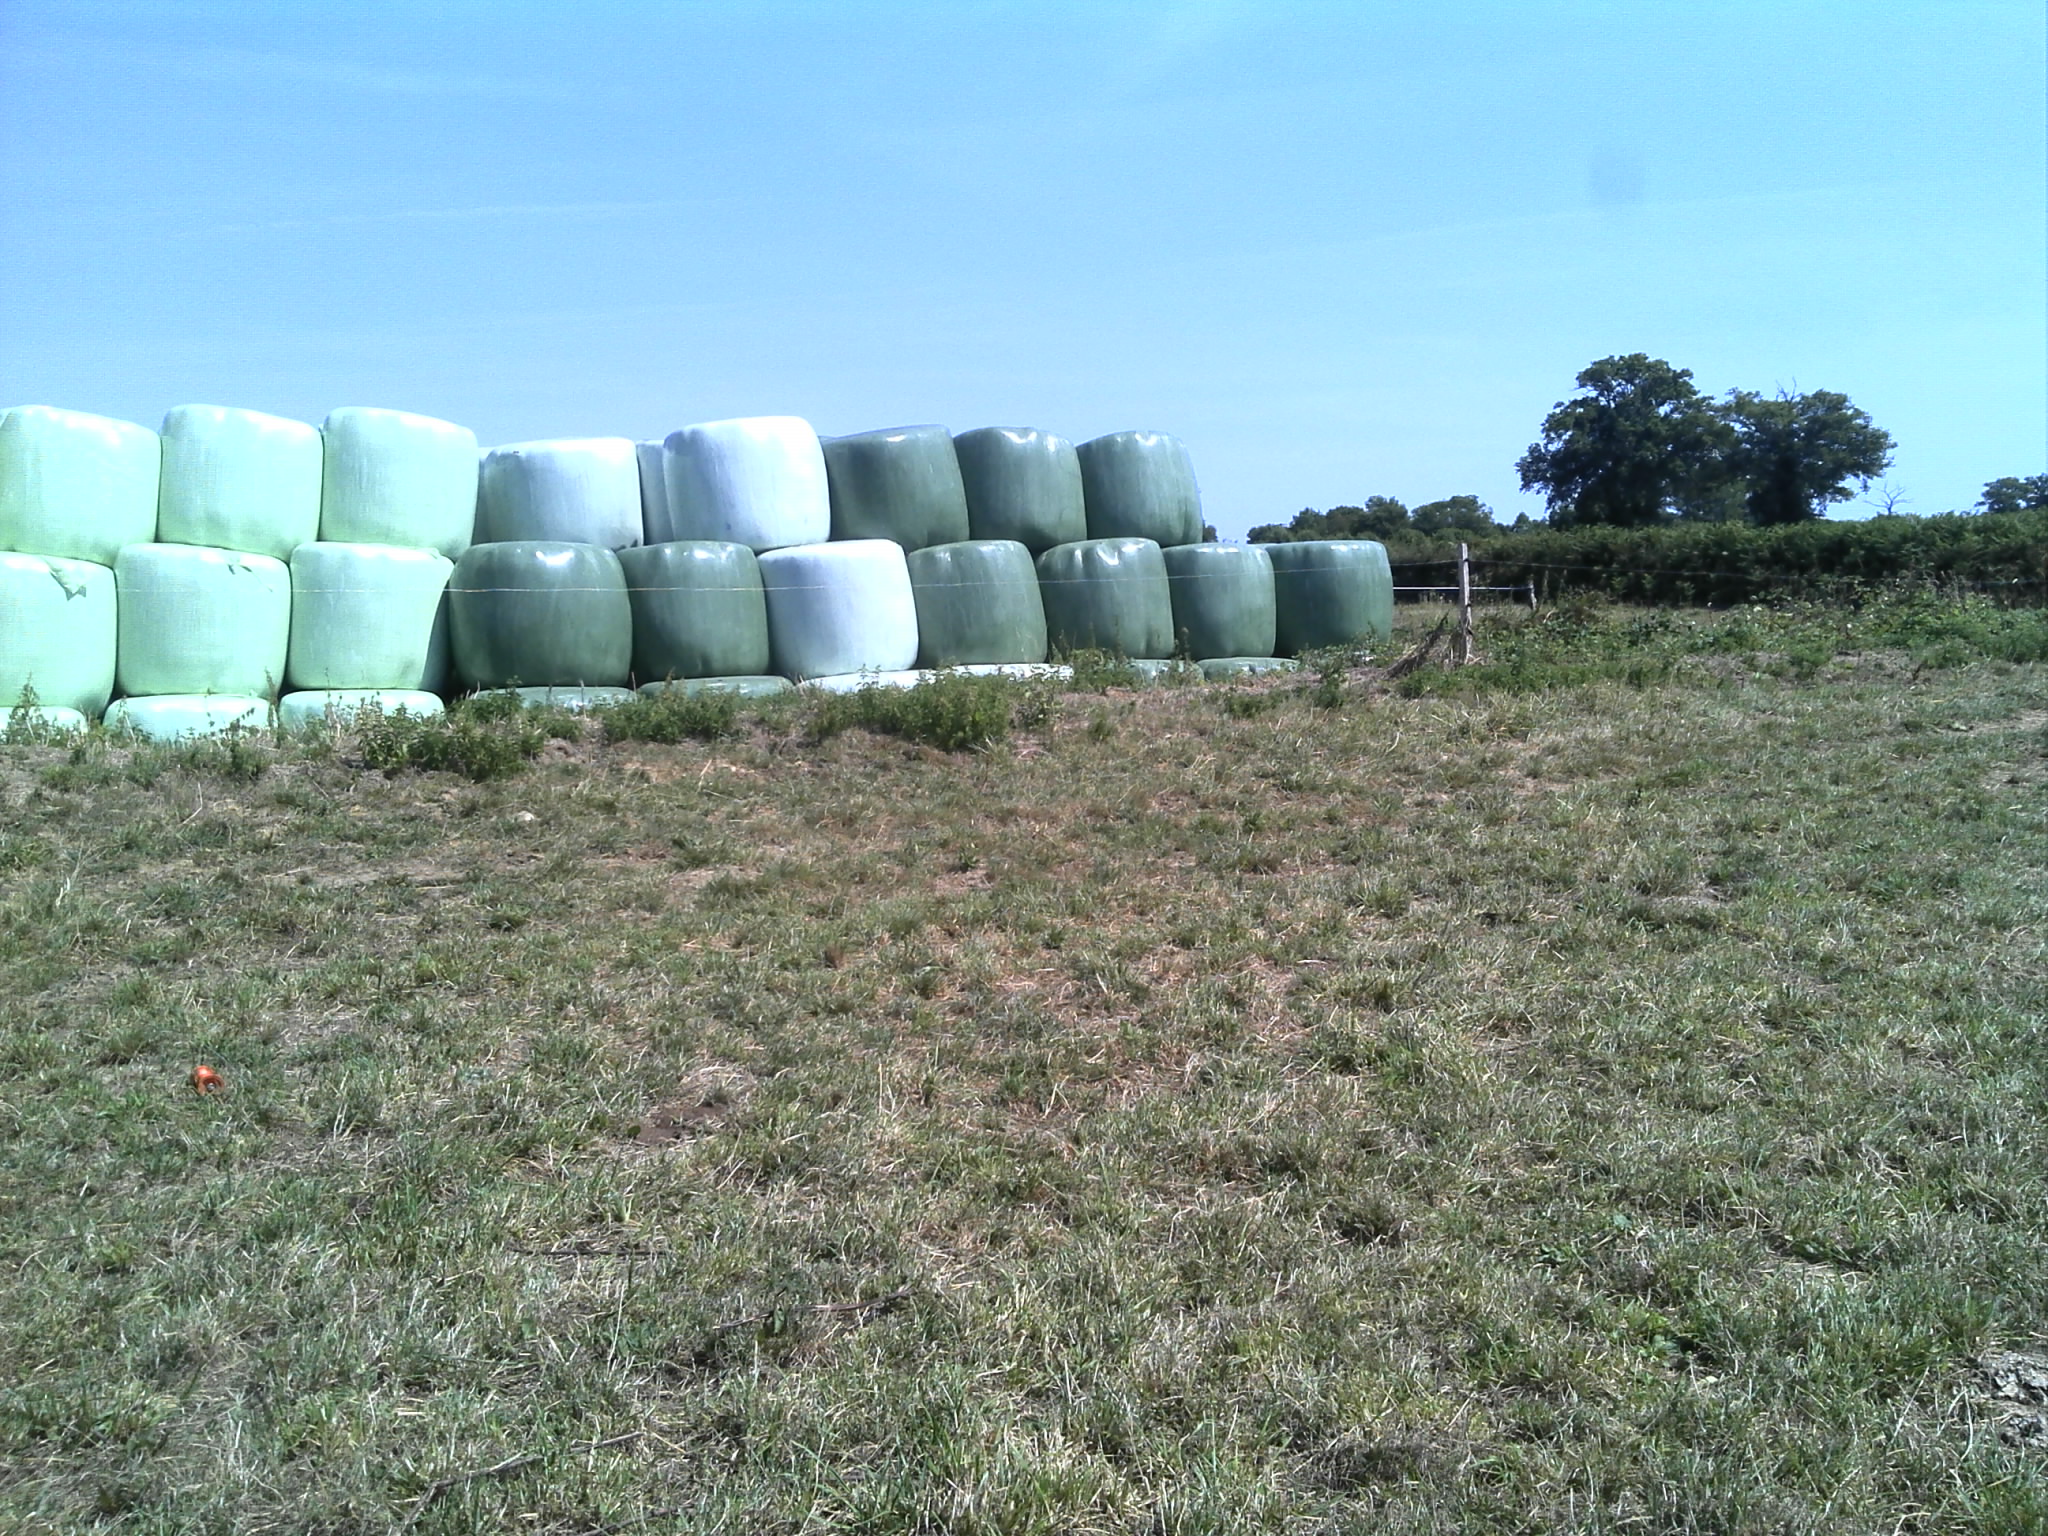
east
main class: Grassland
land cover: Grassland without tree/shrub cover
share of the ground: > 75 %
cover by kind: herbaceous plants 100 %
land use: Agriculture (excluding fallow land and kitchen gardens)
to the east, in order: Grassland without tree/shrub cover; Fences; Grassland without tree/shrub cover; Managed hedges; Common wheat; Managed hedges; Grassland without tree/shrub cover
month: August
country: FR
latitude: 46.4803
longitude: 1.6937
